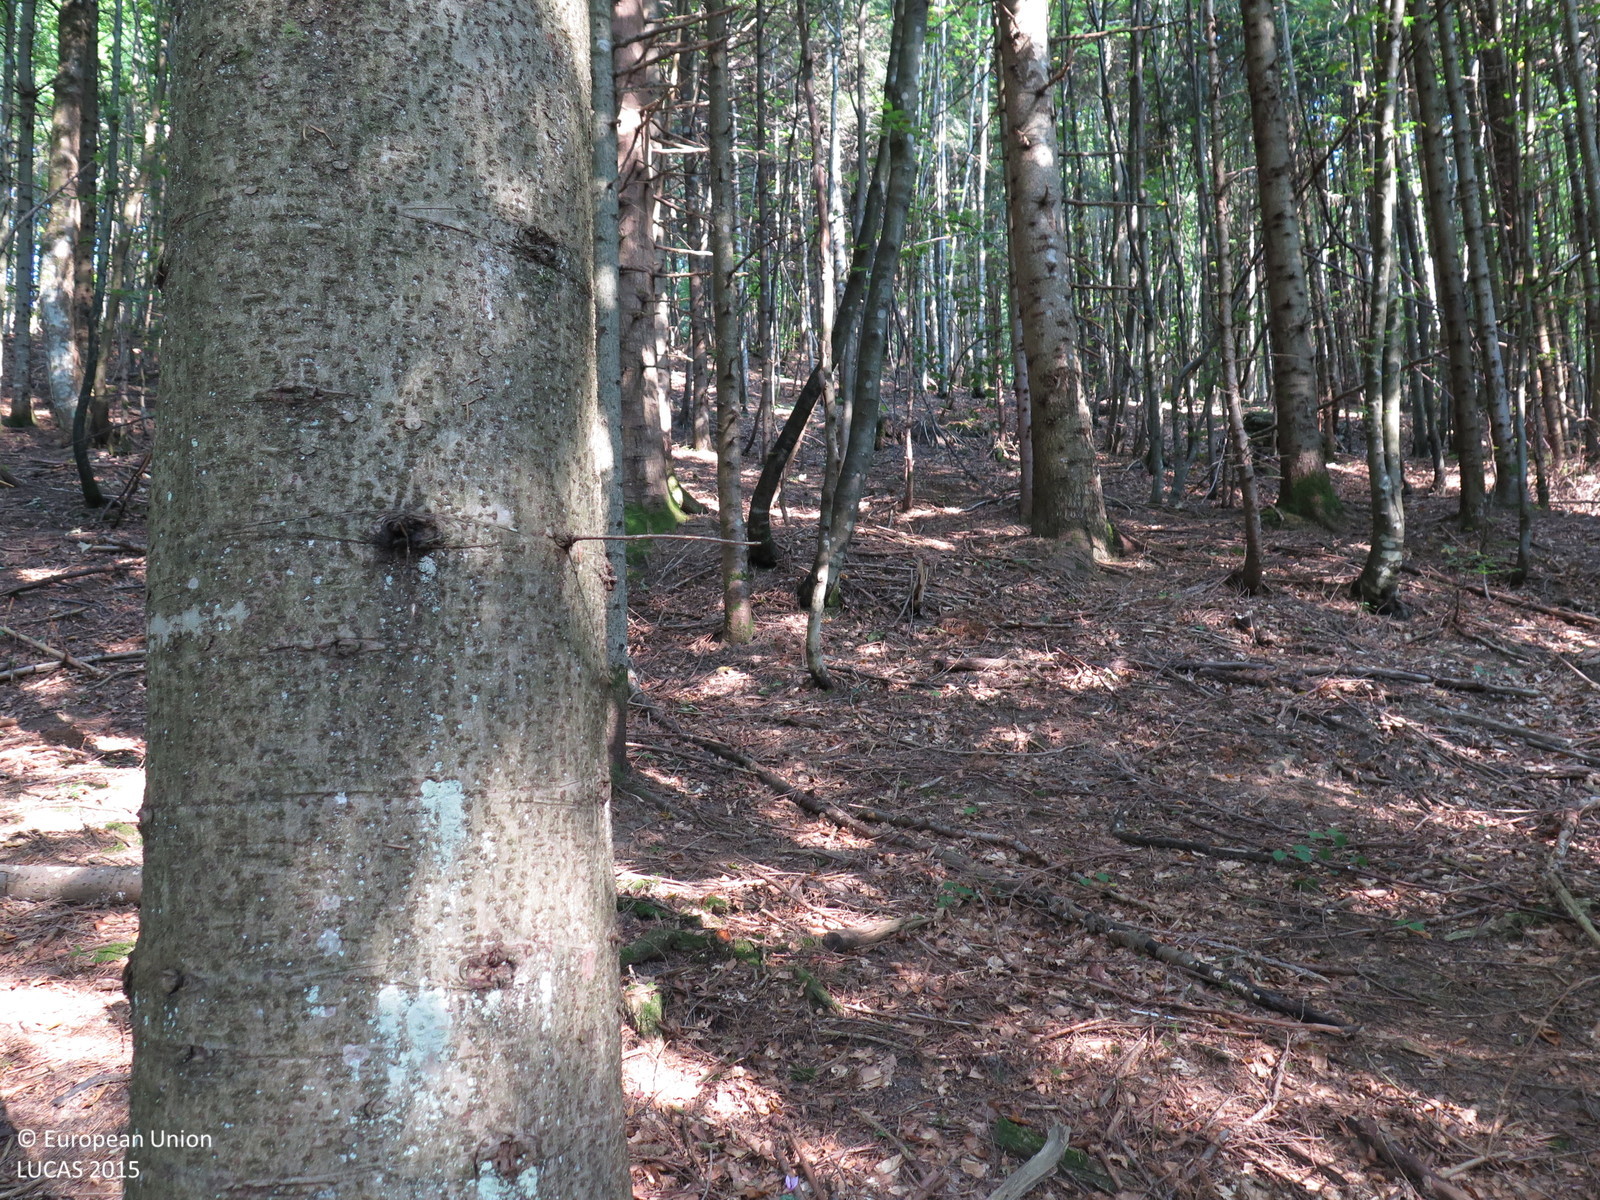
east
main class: Woodland
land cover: Other mixed woodland
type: beech forest
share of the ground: > 75 %
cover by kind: coniferous forest trees 75 %, broadleaved forest trees 25 %
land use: Forestry
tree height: > 5 m
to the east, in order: Other mixed woodland; Tracks; Other mixed woodland
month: August
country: HR
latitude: 45.3469
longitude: 15.0623
